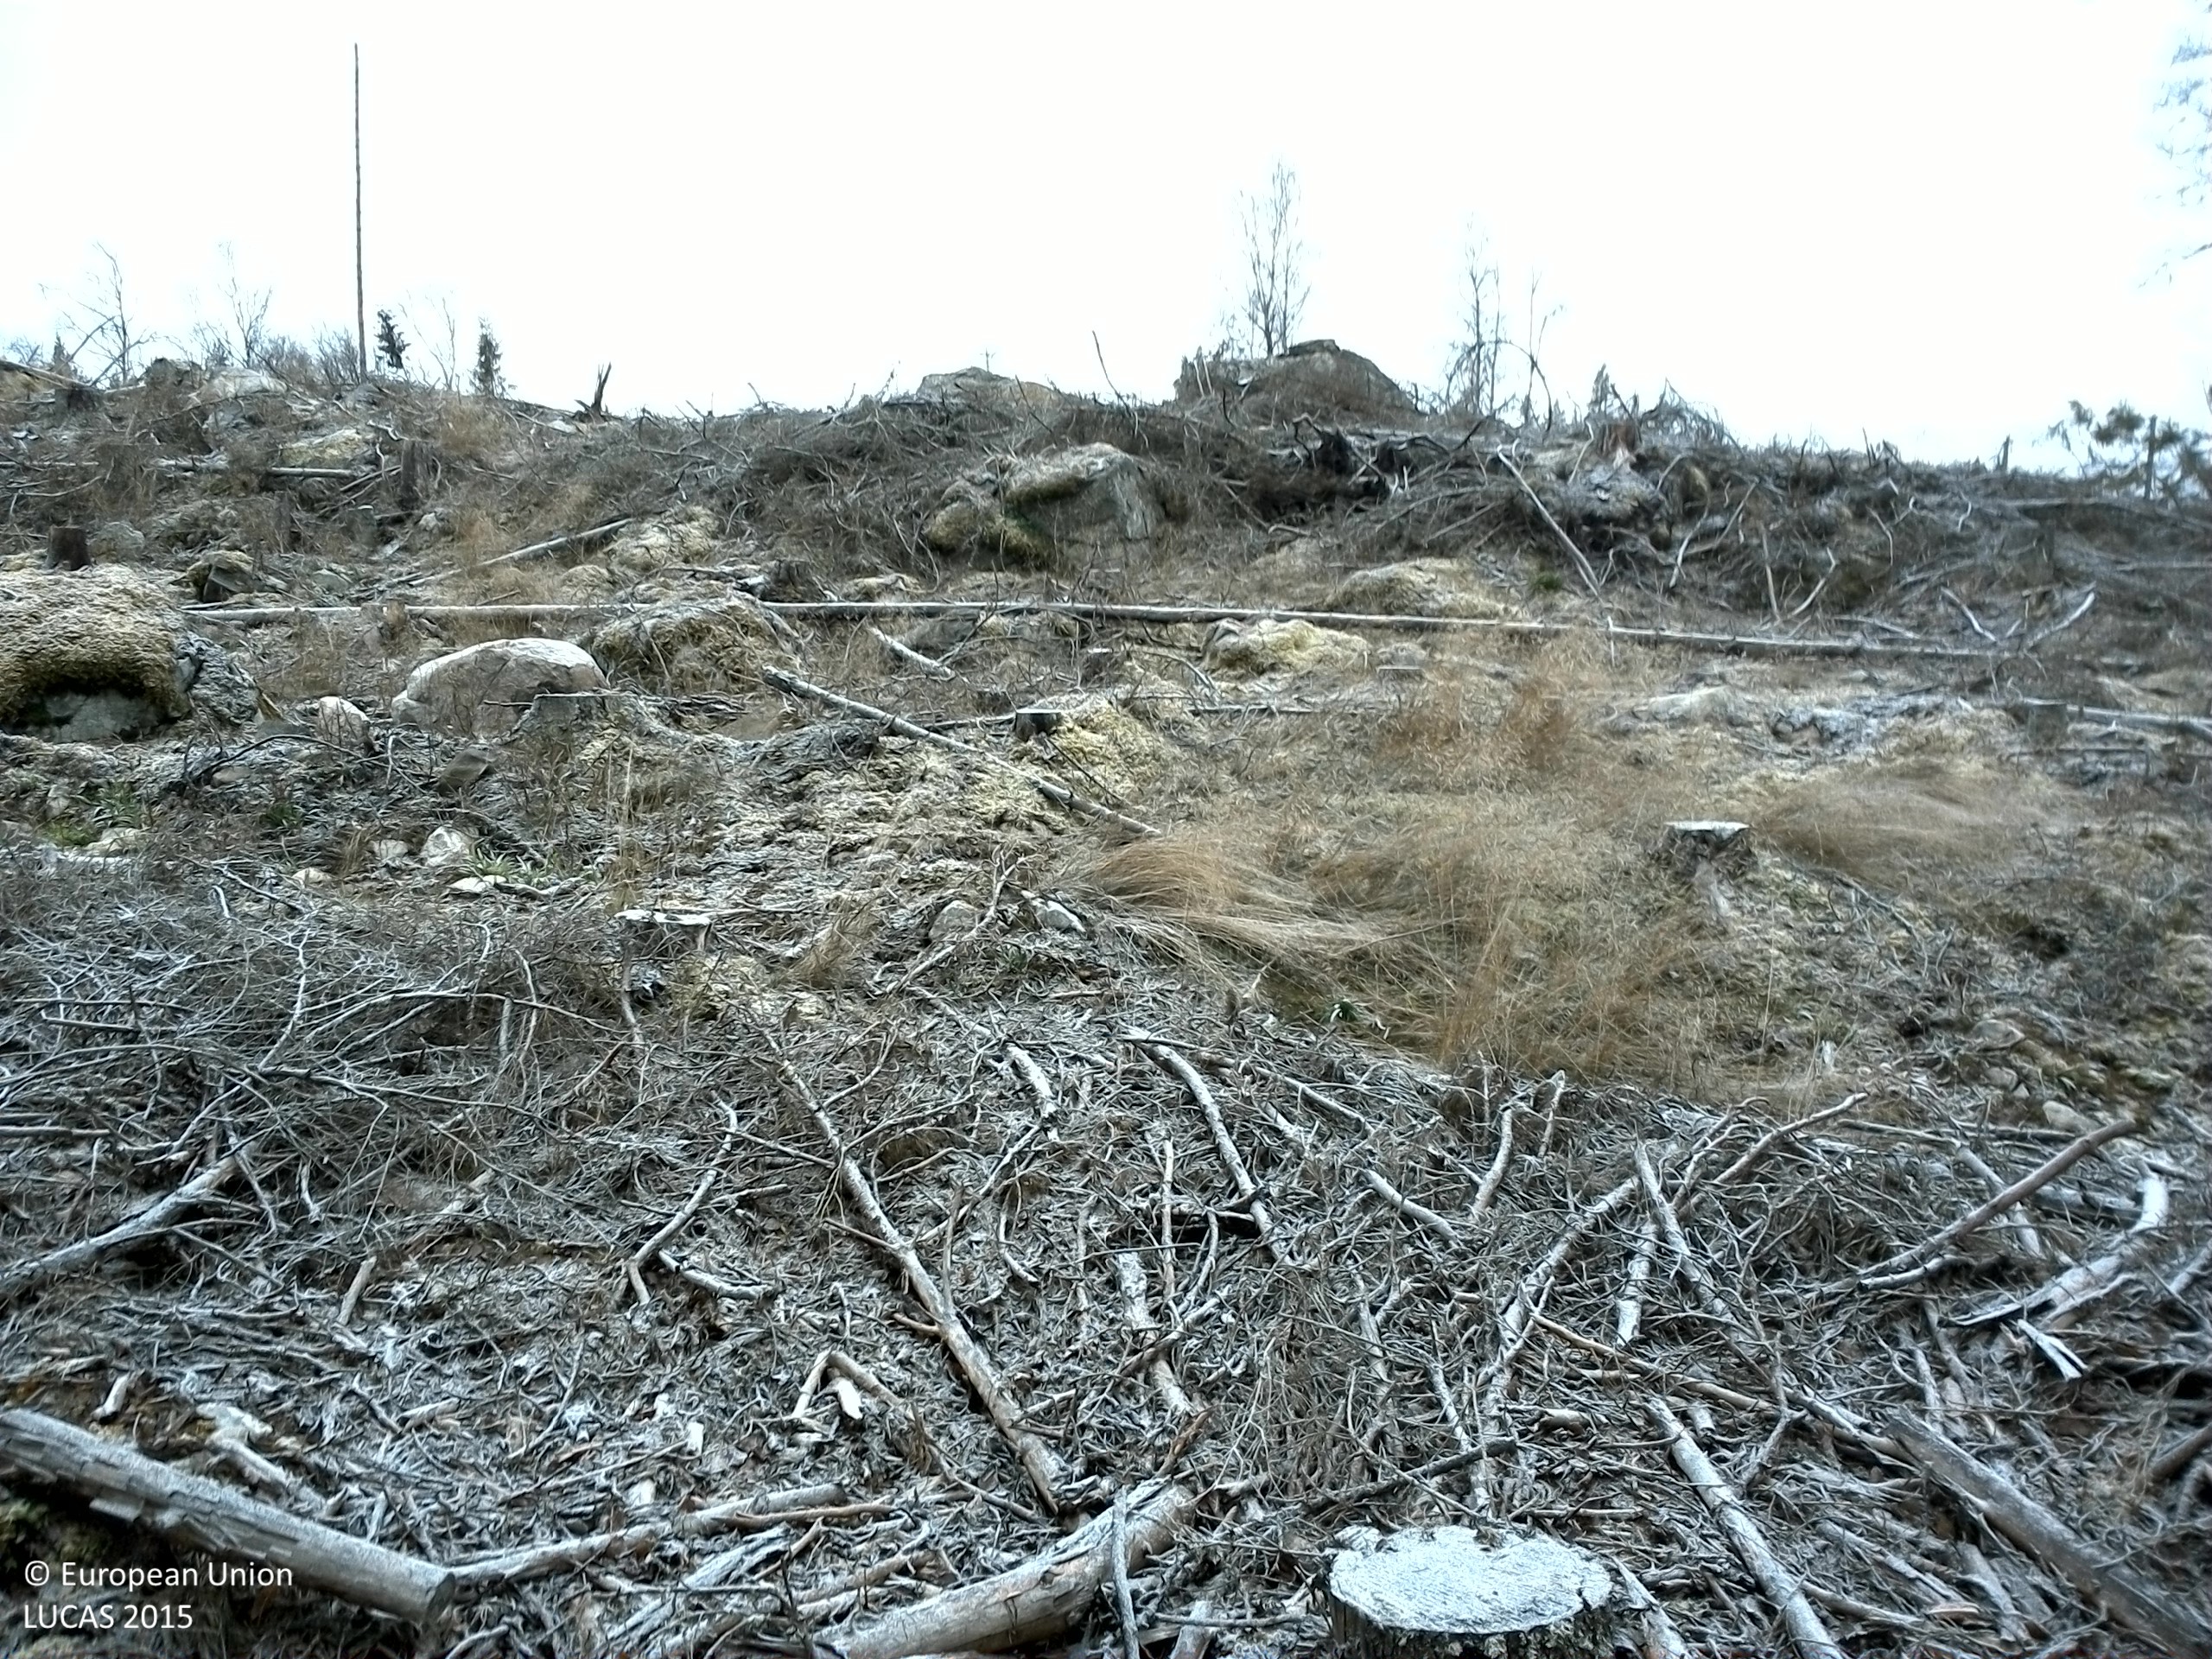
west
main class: Shrubland
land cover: Shrubland without tree cover
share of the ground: 25 - 50 %
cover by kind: shrubs 40 %, consolidated bare surface 30 %, herbaceous plants 15 %, lichens and mosses 15 %
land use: Forestry
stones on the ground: 10 - 25 %
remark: Clear cut
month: November
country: SE
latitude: 60.1393
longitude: 15.6609
